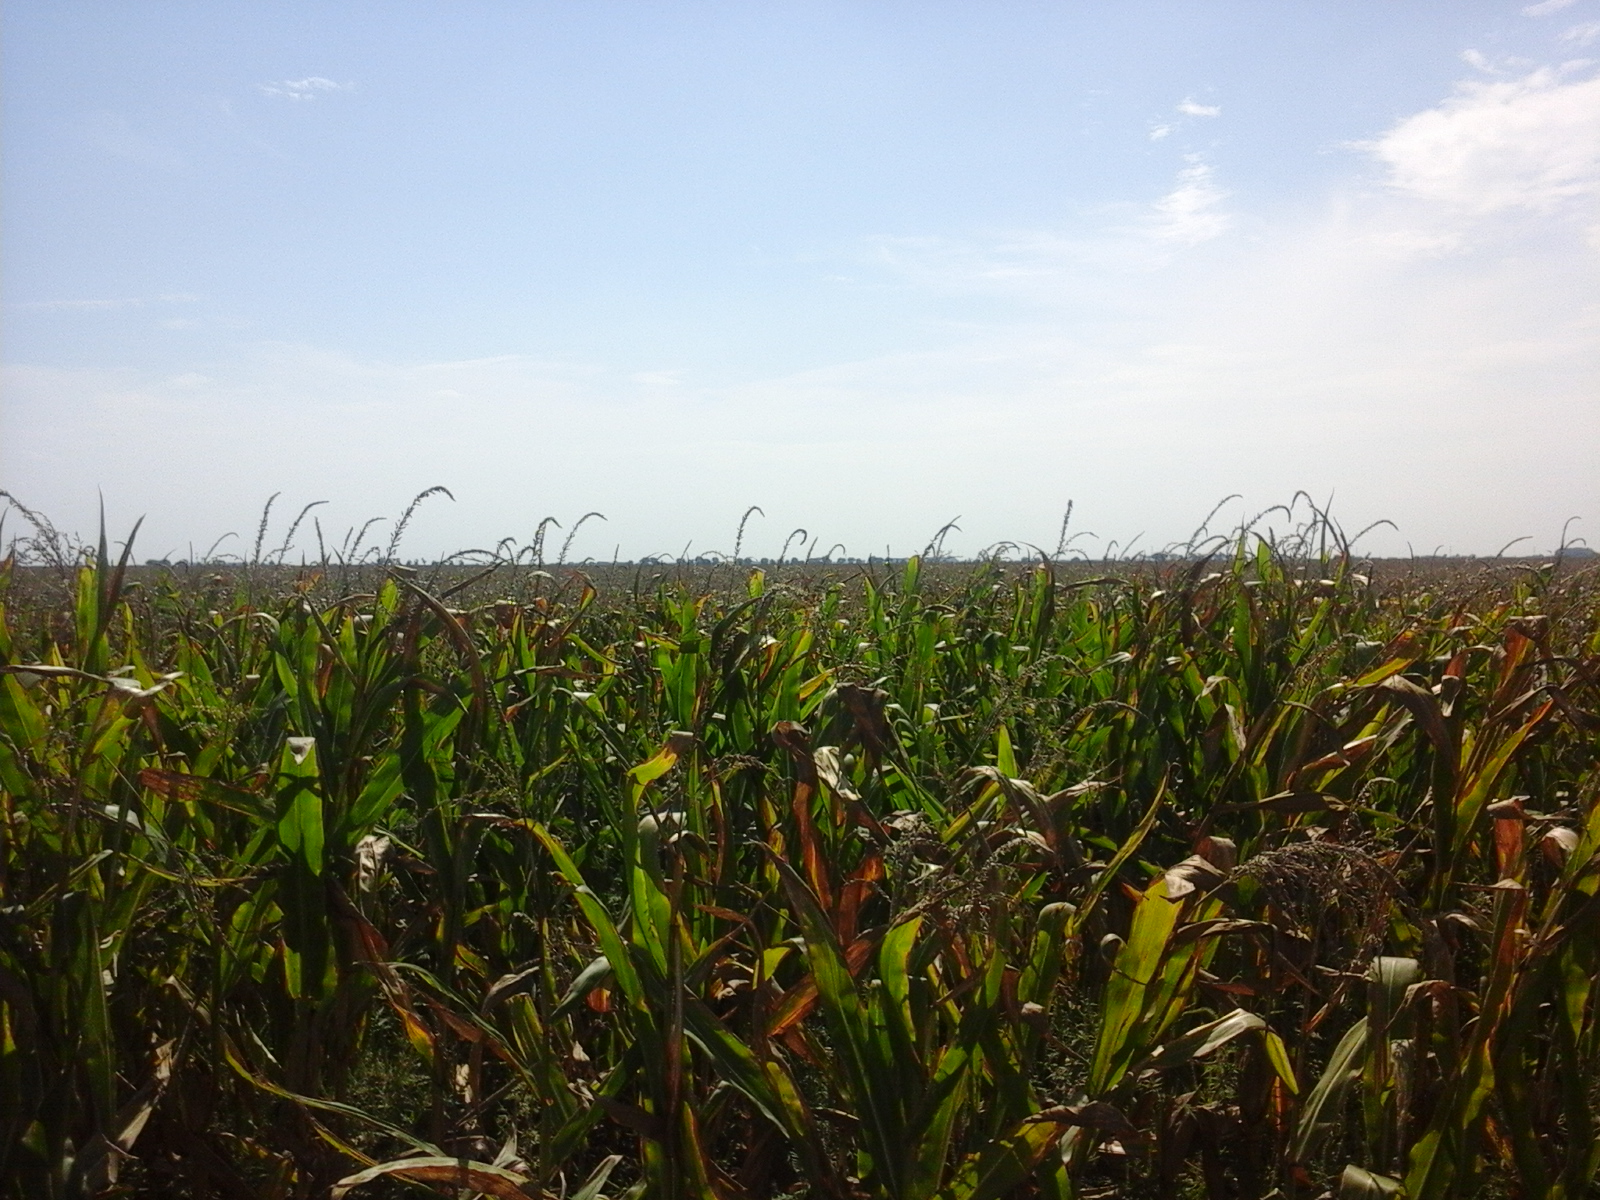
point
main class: Cropland
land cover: Maize
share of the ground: > 75 %
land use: Agriculture (excluding fallow land and kitchen gardens)
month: August
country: RO
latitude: 46.5333
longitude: 21.2874
